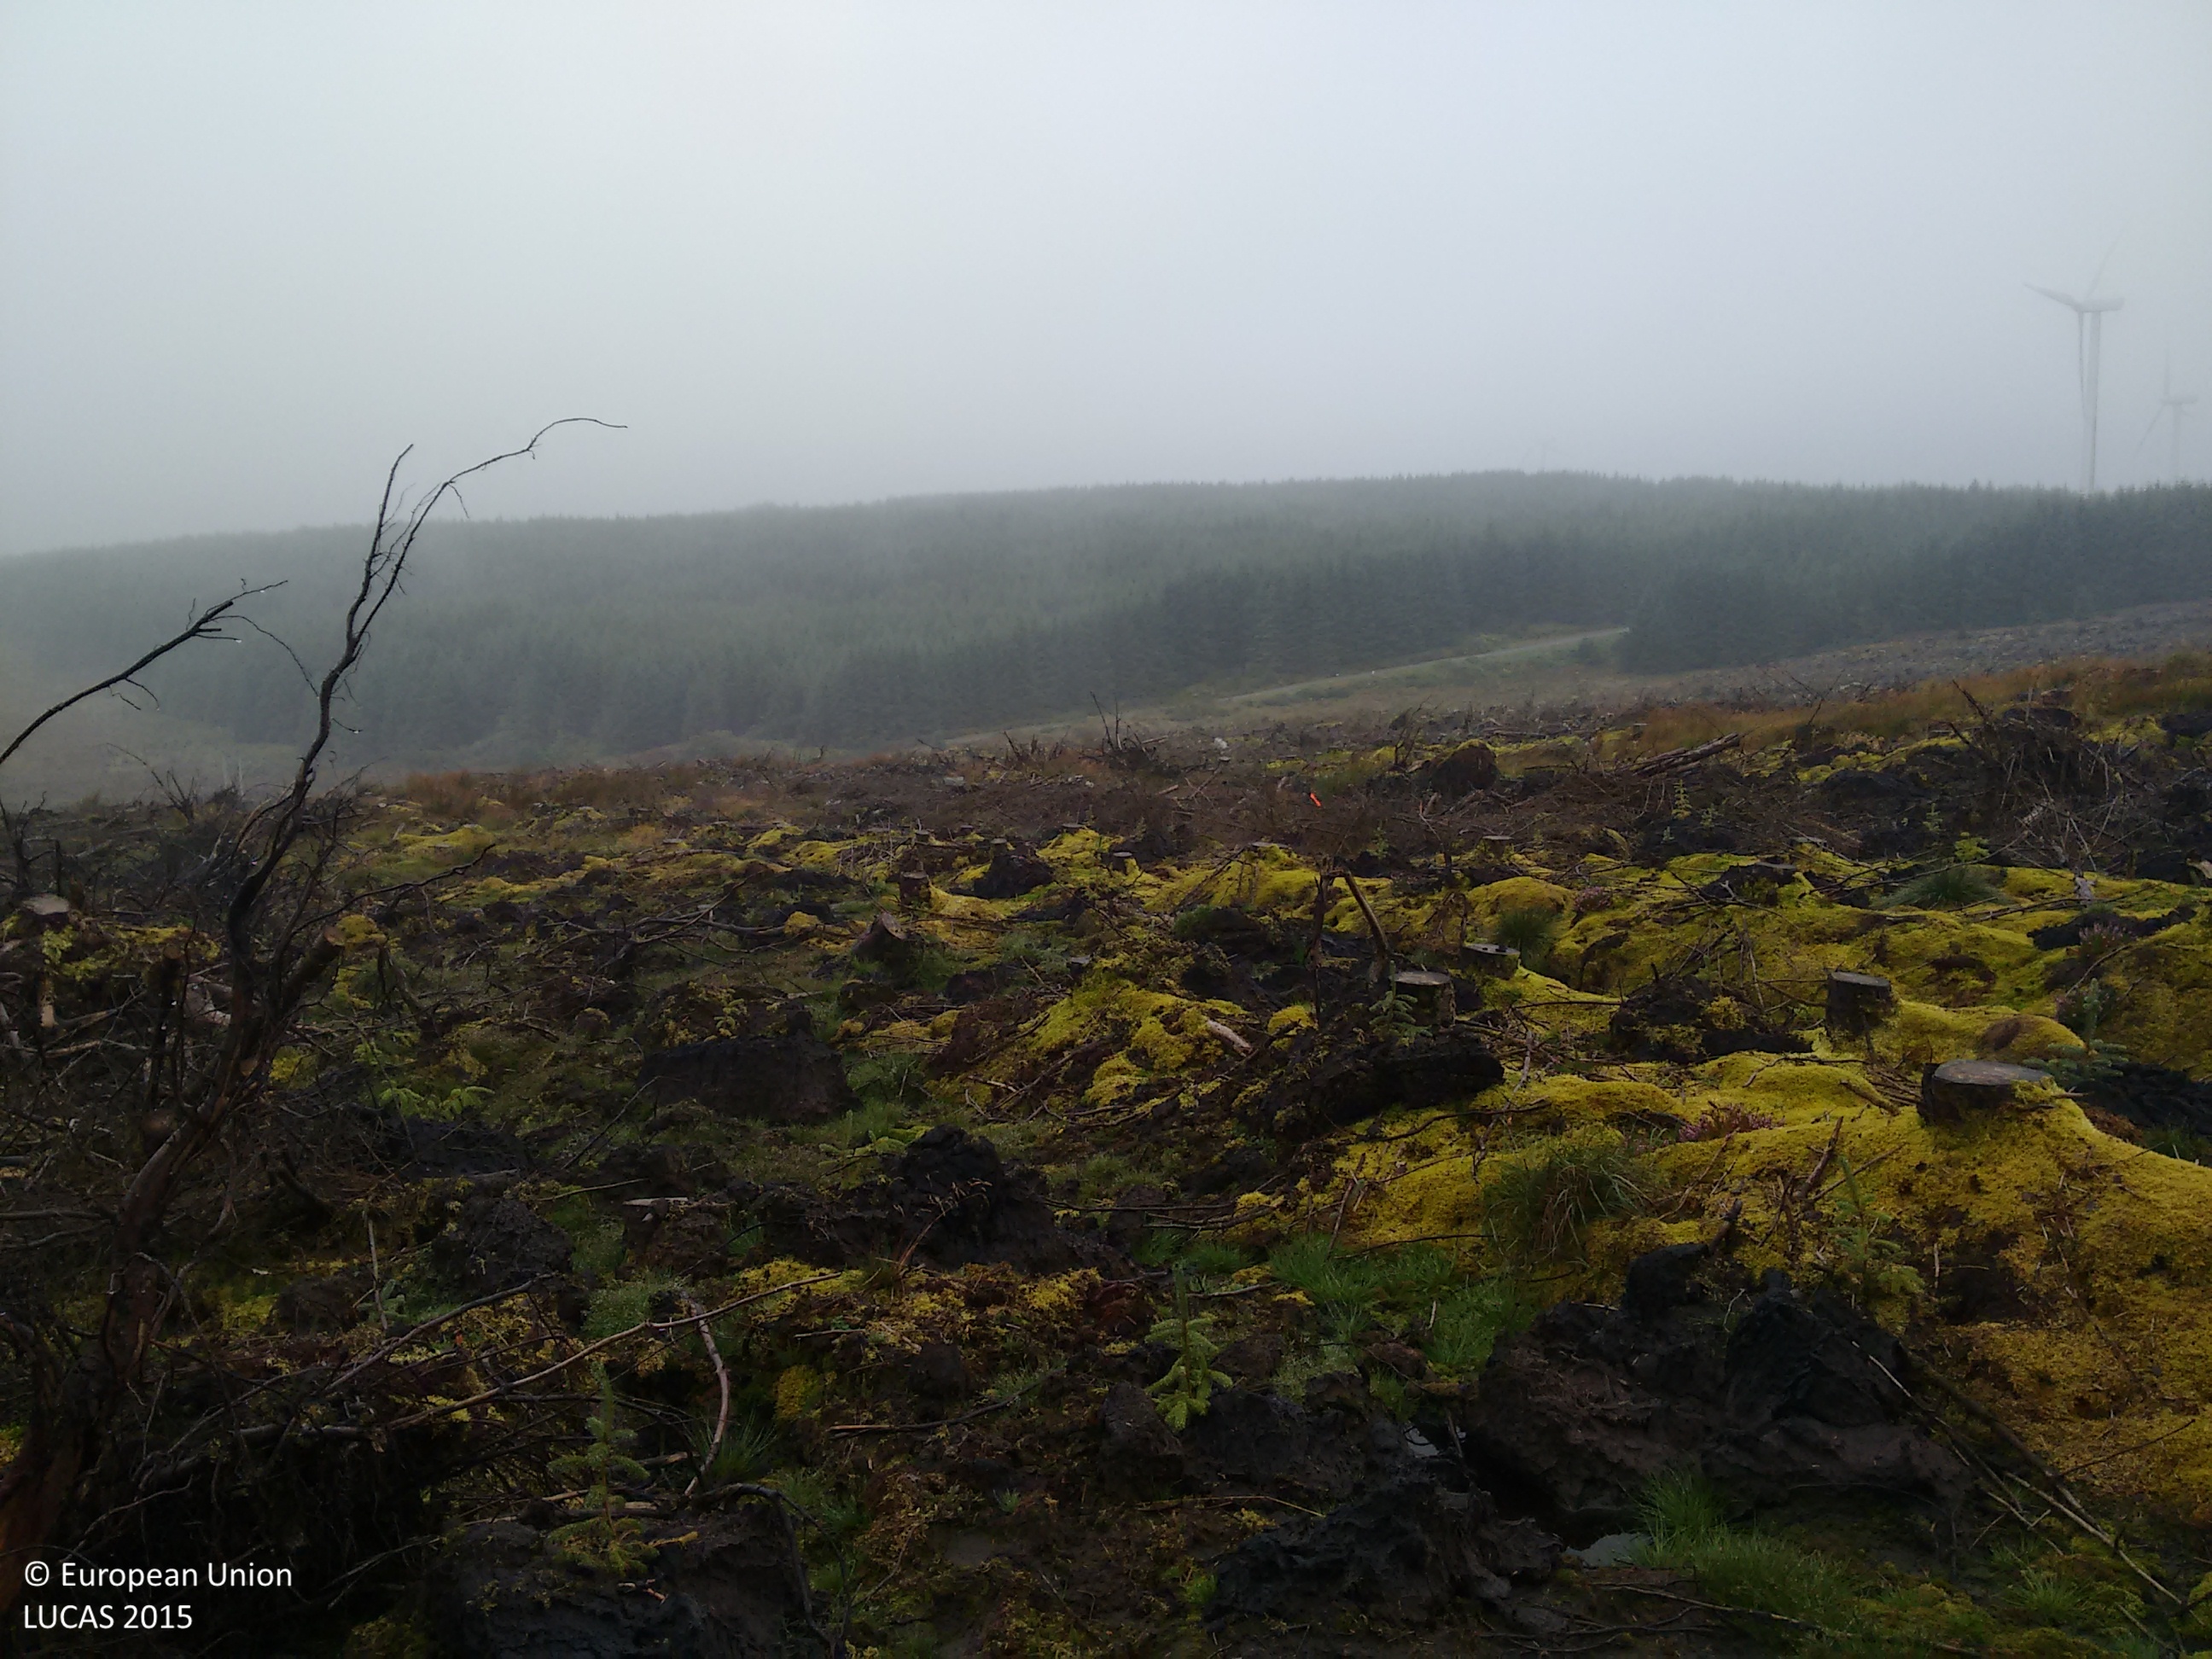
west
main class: Woodland
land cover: Spruce dominated coniferous woodland
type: exotic forest
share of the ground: > 75 %
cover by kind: coniferous forest trees 100 %
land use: Forestry
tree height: > 5 m
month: September
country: GB
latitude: 55.6350
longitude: -5.5496
